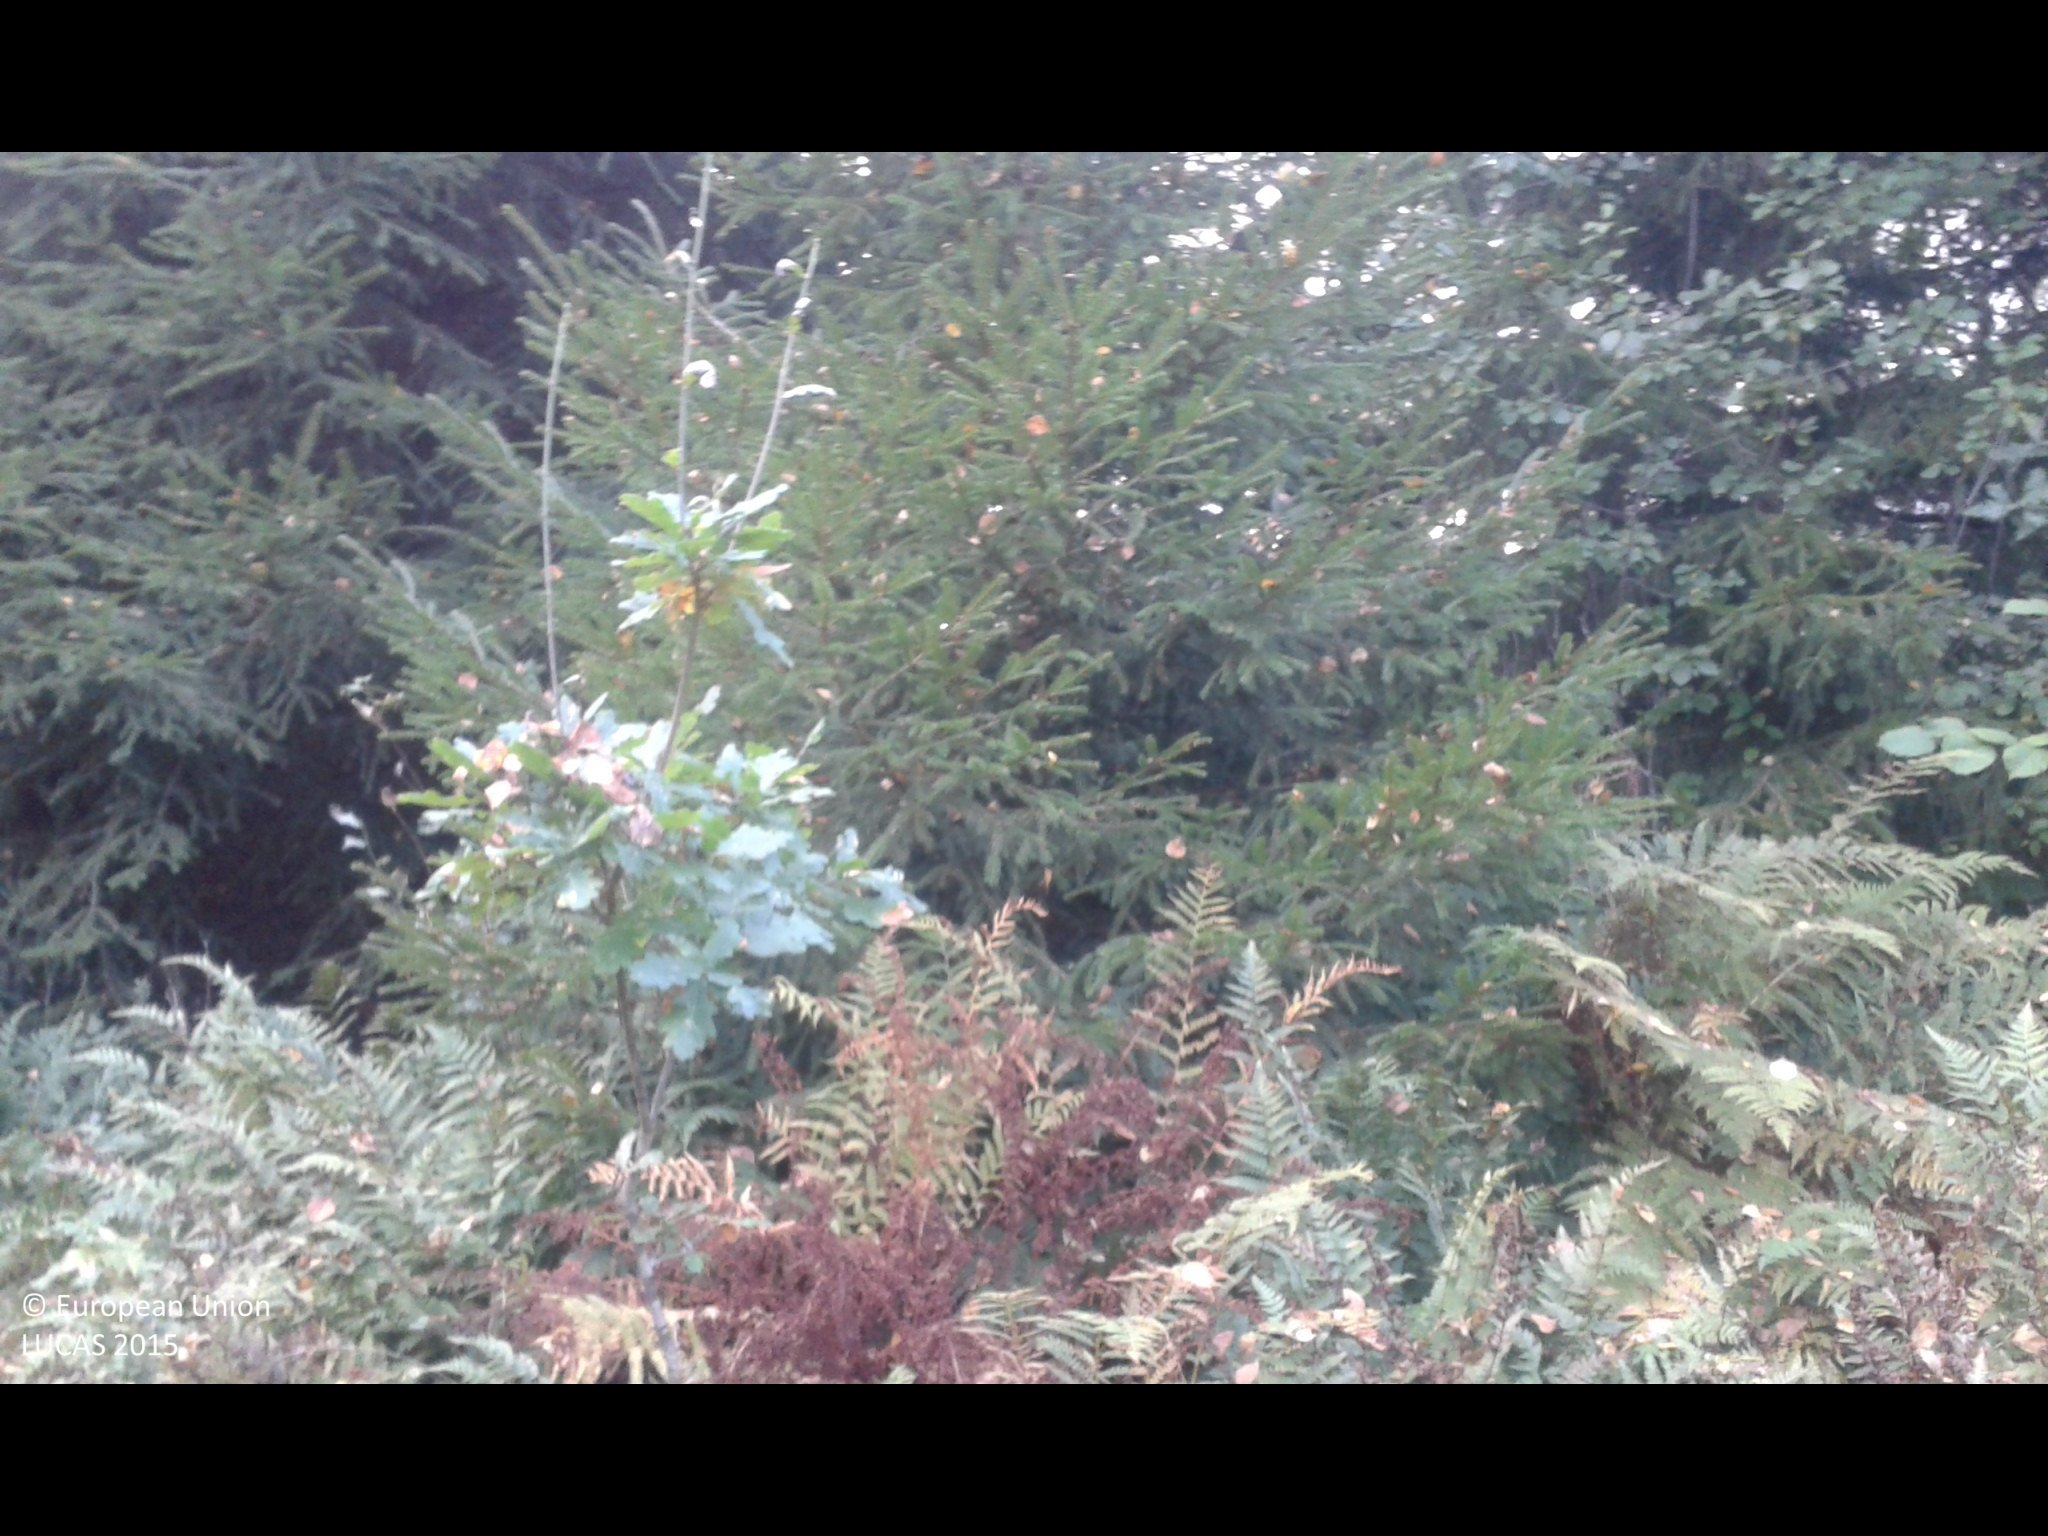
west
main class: Woodland
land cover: Spruce dominated mixed woodland
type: hemiboreal forest and nemoral coniferous forest and mixed broadleaved-coniferous forest
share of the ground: 50 - 75 %
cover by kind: broadleaved forest trees 45 %, herbaceous plants 40 %, coniferous forest trees 15 %
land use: Forestry
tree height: > 5 m
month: September
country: SE
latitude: 58.9346
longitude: 17.4513
